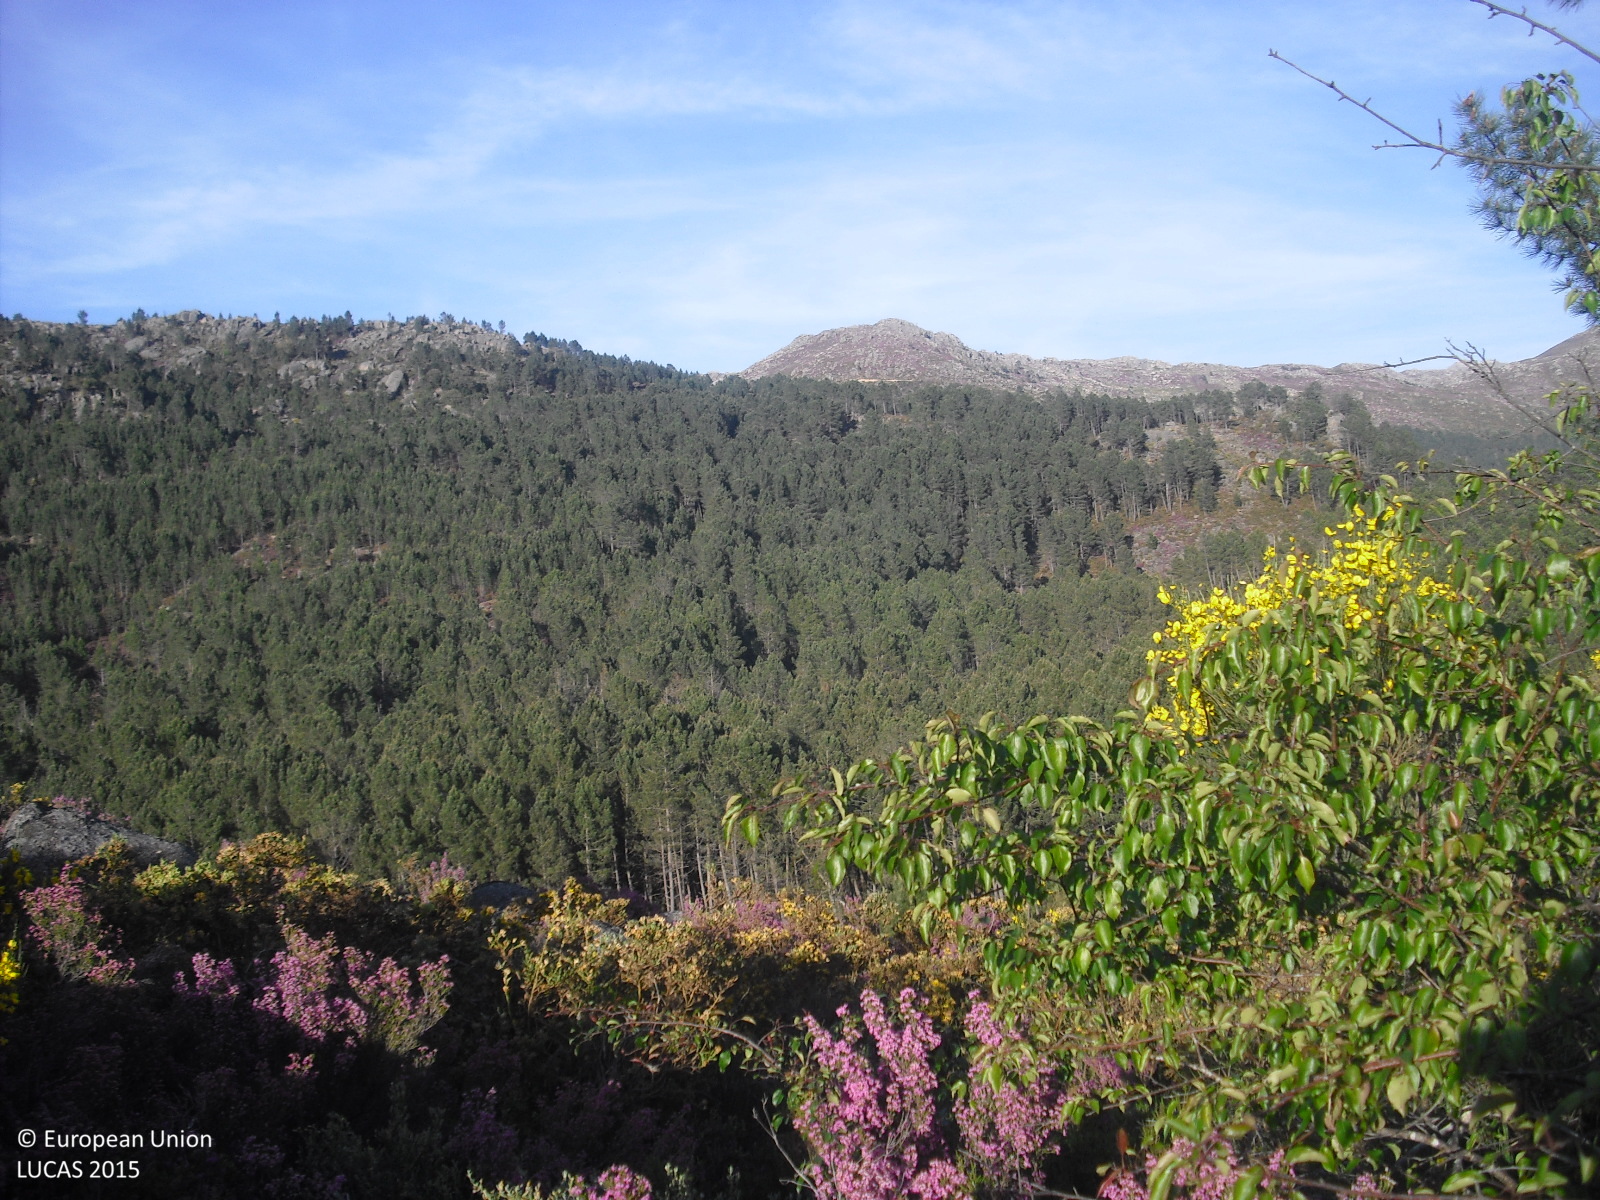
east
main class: Shrubland
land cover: Shrubland with sparse tree cover
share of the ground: > 75 %
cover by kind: shrubs 75 %, consolidated bare surface 20 %, coniferous forest trees 5 %
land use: Semi-natural and natural areas not in use
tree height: < 5 m
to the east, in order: Shrubland with sparse tree cover; Rock outcrops; Shrubland without tree cover; Dry stone walls; Shrubland without tree cover; Shrubland with sparse tree cover; Tracks; Shrubland with sparse tree cover; Rock outcrops; Shrubland with sparse tree cover; Rivers and streams; Pine dominated coniferous woodland; Rivers and streams; Pine dominated coniferous woodland
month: May
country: ES
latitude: 41.8373
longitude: -8.1040
